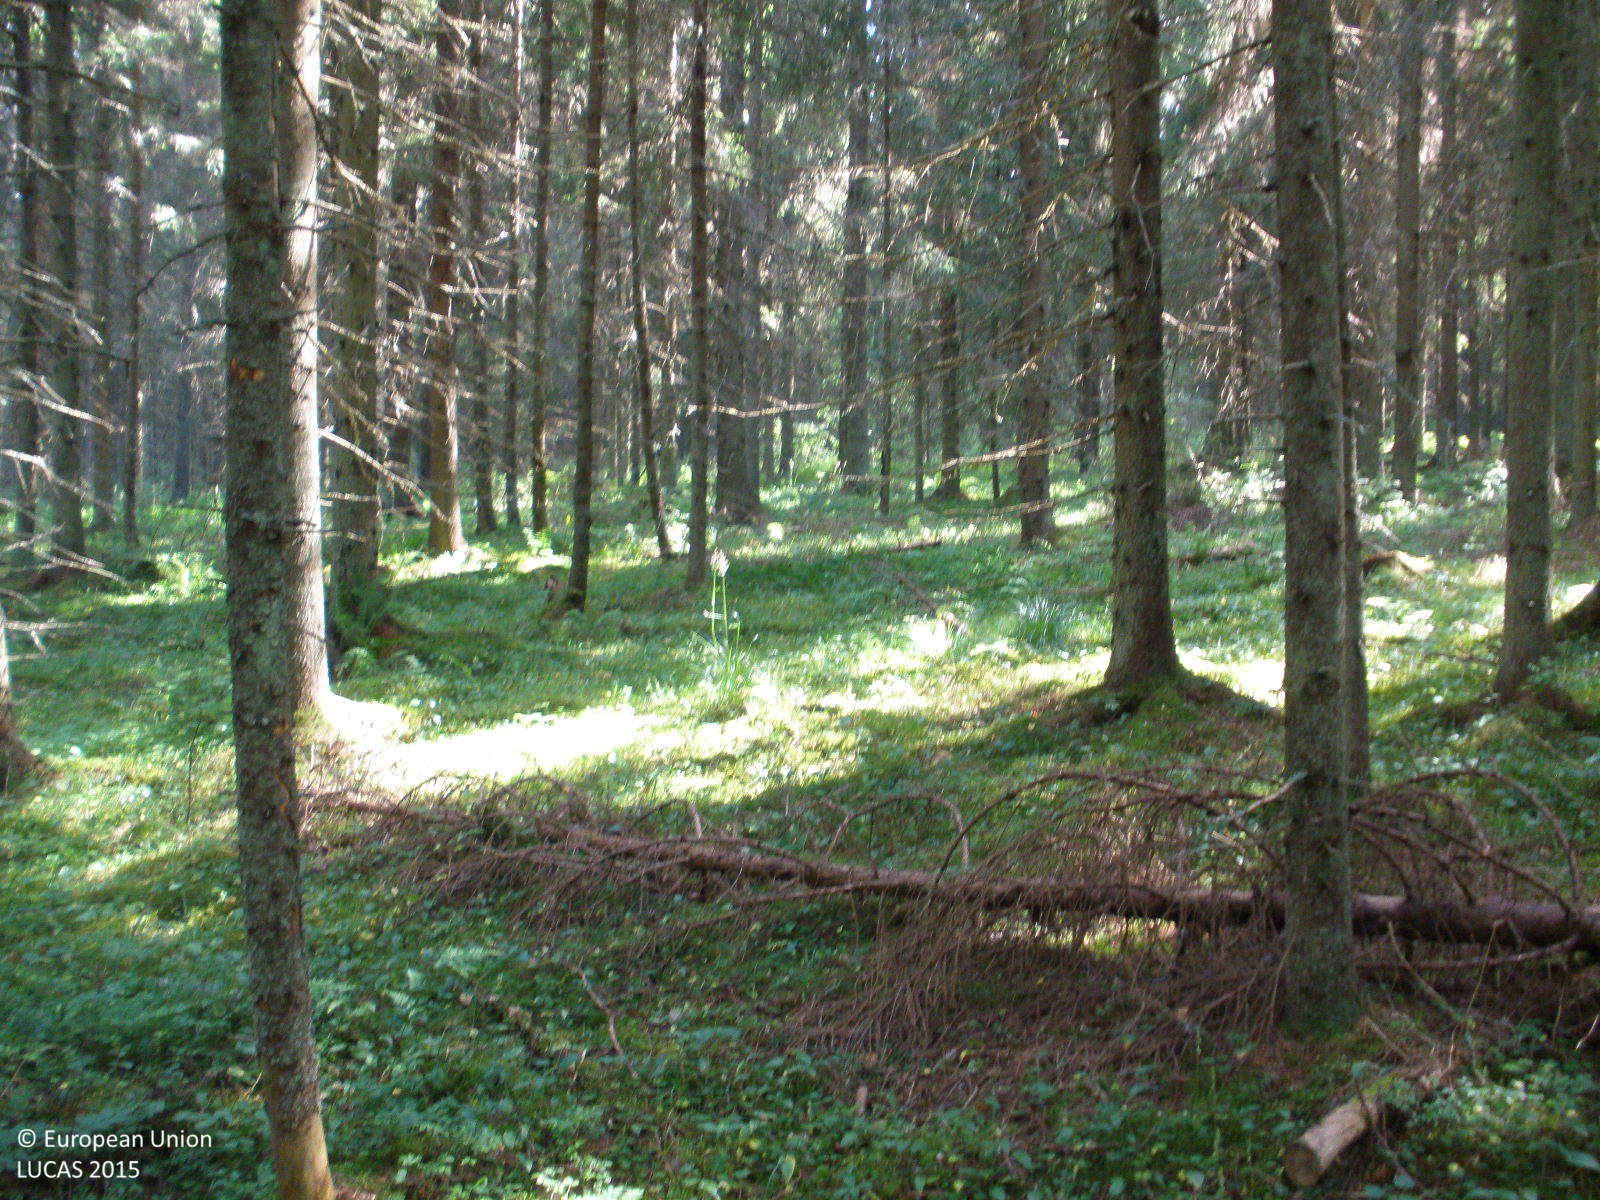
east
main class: Woodland
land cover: Spruce dominated coniferous woodland
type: boreal forest
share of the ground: > 75 %
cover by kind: coniferous forest trees 90 %, herbaceous plants 5 %, lichens and mosses 5 %
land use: Forestry
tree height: > 5 m
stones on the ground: < 10 %
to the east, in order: Spruce dominated coniferous woodland; Ditches and canals; Spruce dominated mixed woodland; Broadleaved woodland
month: August
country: FI
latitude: 60.9802
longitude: 24.9137
